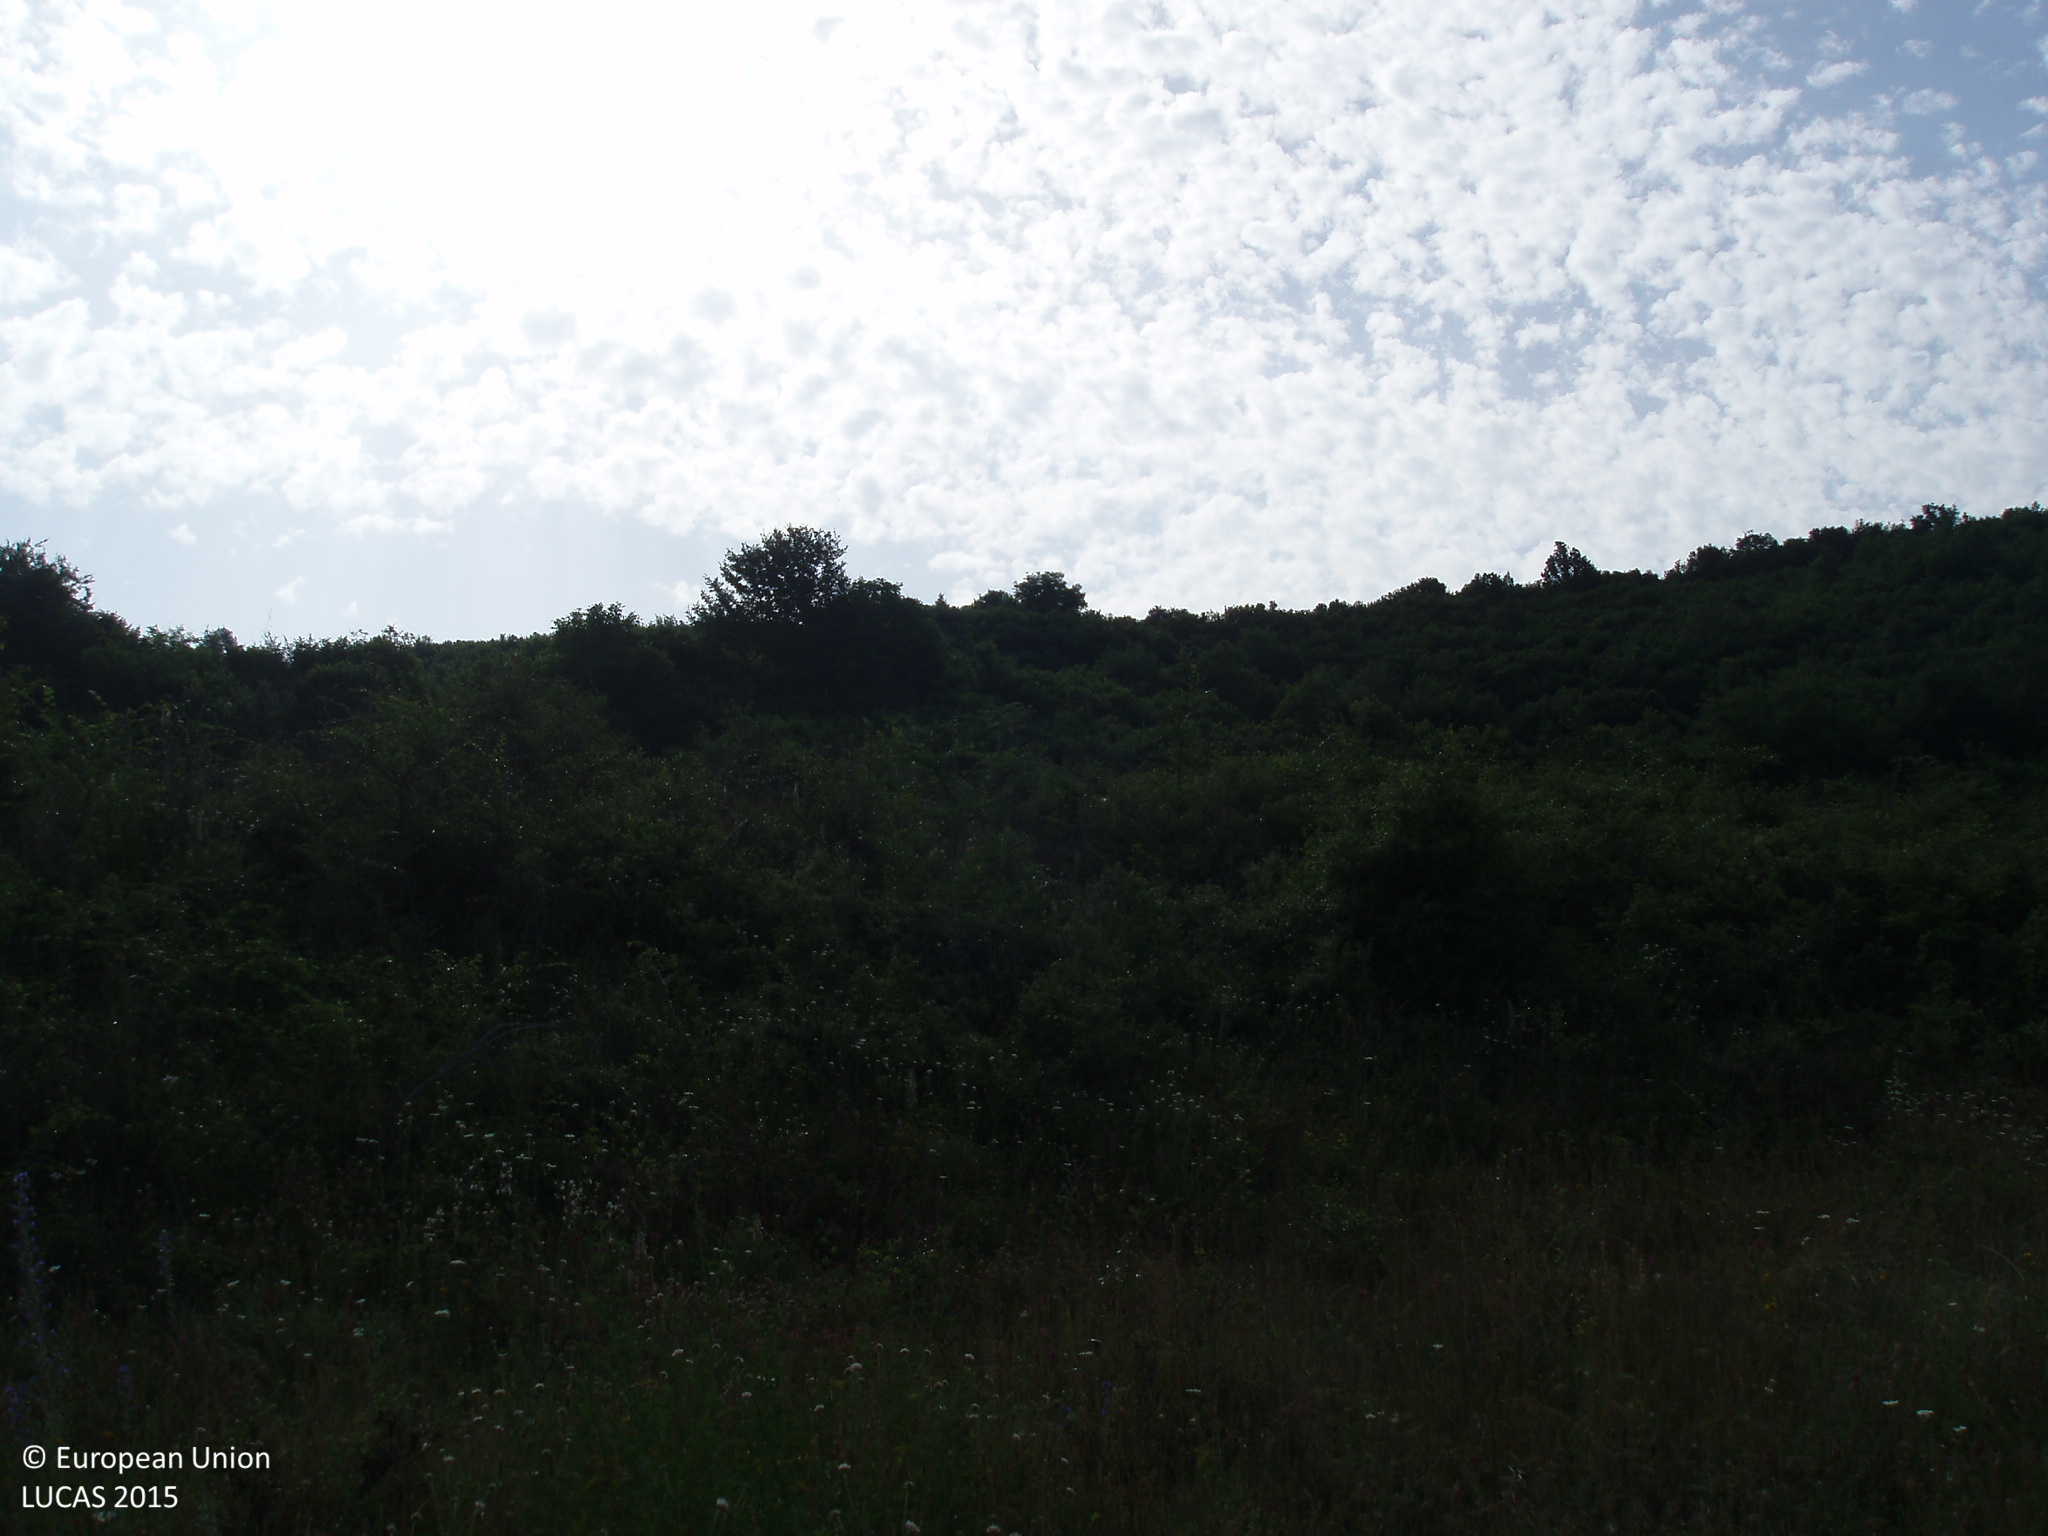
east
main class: Grassland
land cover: Grassland without tree/shrub cover
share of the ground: > 75 %
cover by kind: herbaceous plants 100 %
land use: Agriculture (excluding fallow land and kitchen gardens)
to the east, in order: Grassland without tree/shrub cover; Shrubland with sparse tree cover; Broadleaved woodland; Grassland without tree/shrub cover; Broadleaved woodland
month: June
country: BG
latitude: 41.4651
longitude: 23.8091
